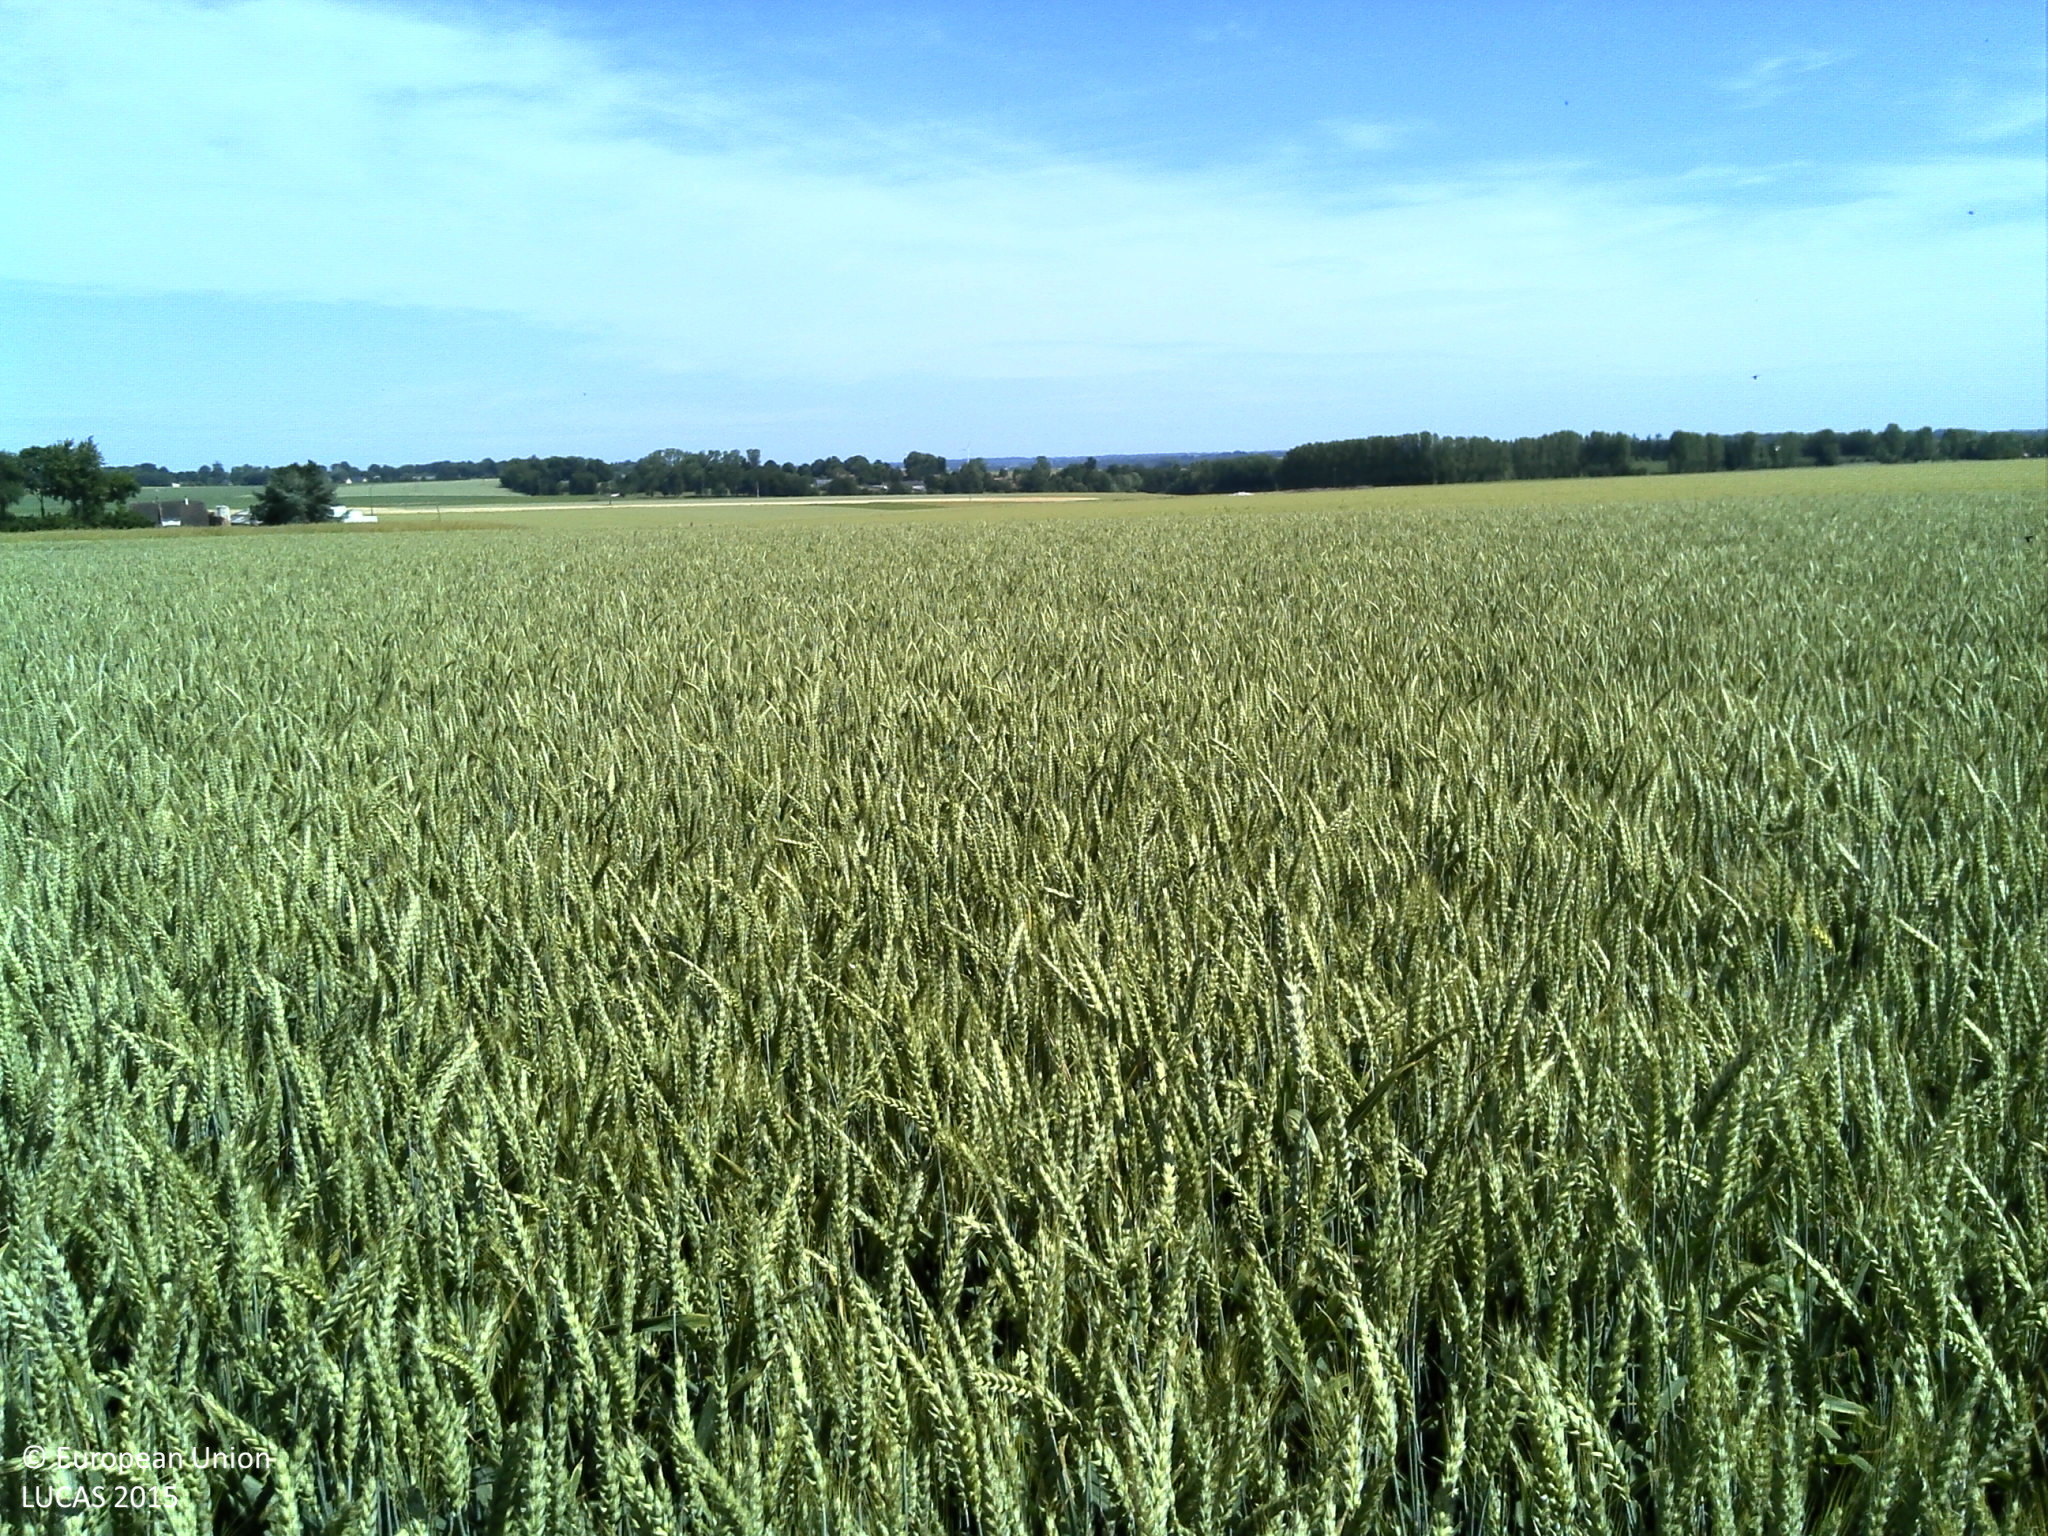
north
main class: Cropland
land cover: Common wheat
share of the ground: > 75 %
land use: Agriculture (excluding fallow land and kitchen gardens)
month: June
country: FR
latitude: 49.7707
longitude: 0.9658
